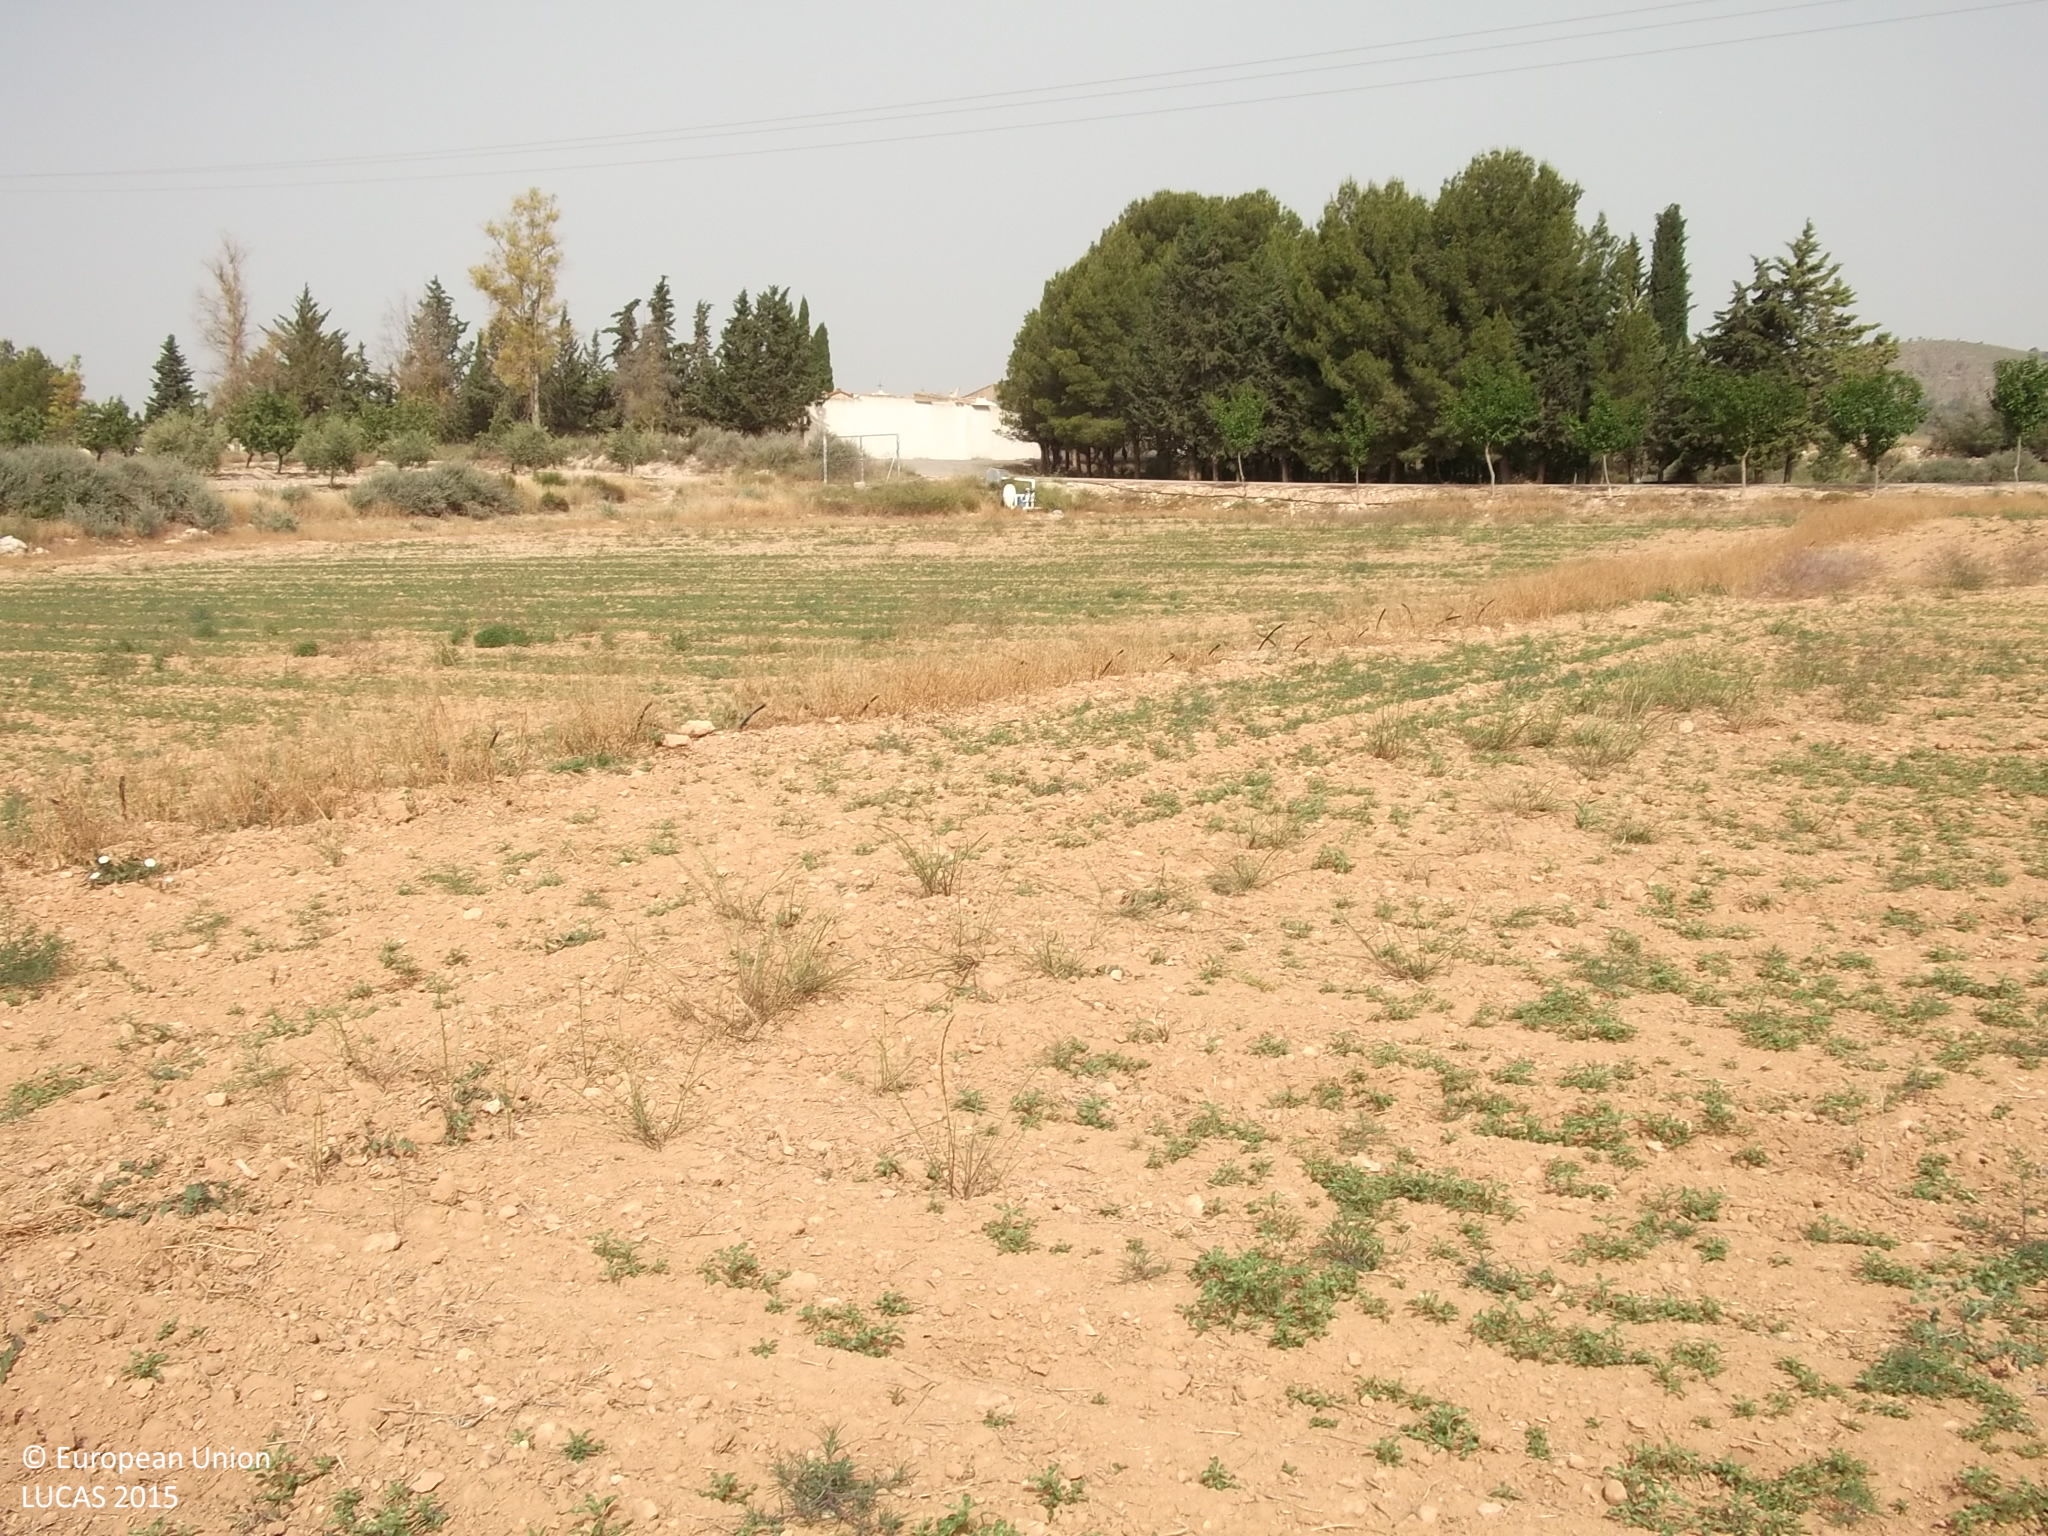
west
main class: Grassland
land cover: Spontaneously vegetated surfaces
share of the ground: 25 - 50 %
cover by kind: unconsolidated bare surface 70 %, herbaceous plants 30 %
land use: Fallow land
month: May
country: ES
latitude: 38.4206
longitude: -1.6404
